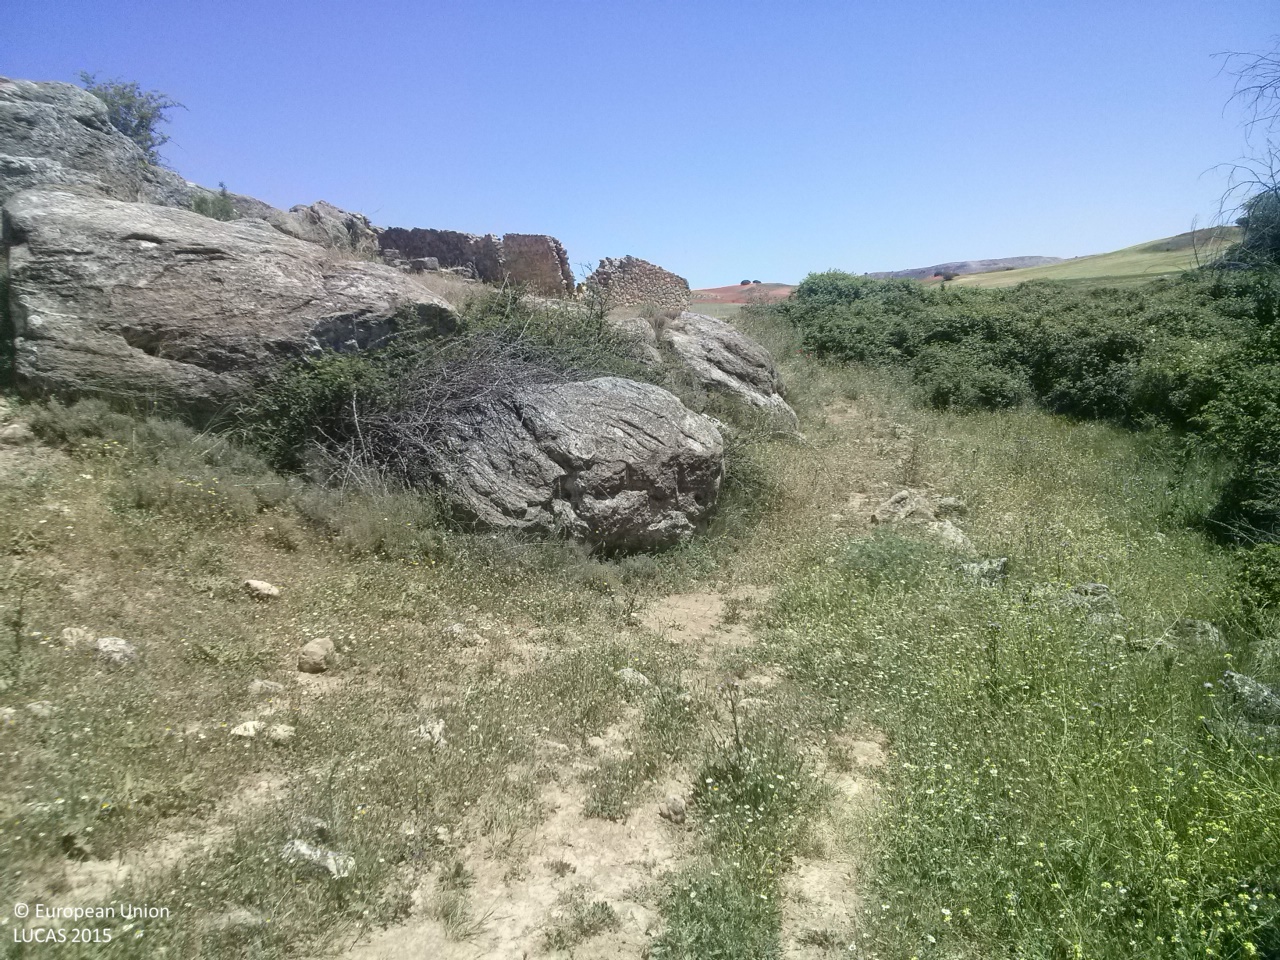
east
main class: Shrubland
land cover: Shrubland without tree cover
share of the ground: 25 - 50 %
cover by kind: shrubs 50 %, herbaceous plants 30 %, unconsolidated bare surface 20 %
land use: Semi-natural and natural areas not in use
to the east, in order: Shrubland without tree cover; Artificial constructions in urban areas; Grassland without tree/shrub cover; Abandoned hedges; Rivers and streams; Abandoned hedges; Sunflower; Grass margins; Barley; Grass margins; Tracks; Grass margins; Barley
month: May
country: ES
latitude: 40.2718
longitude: -2.7604
